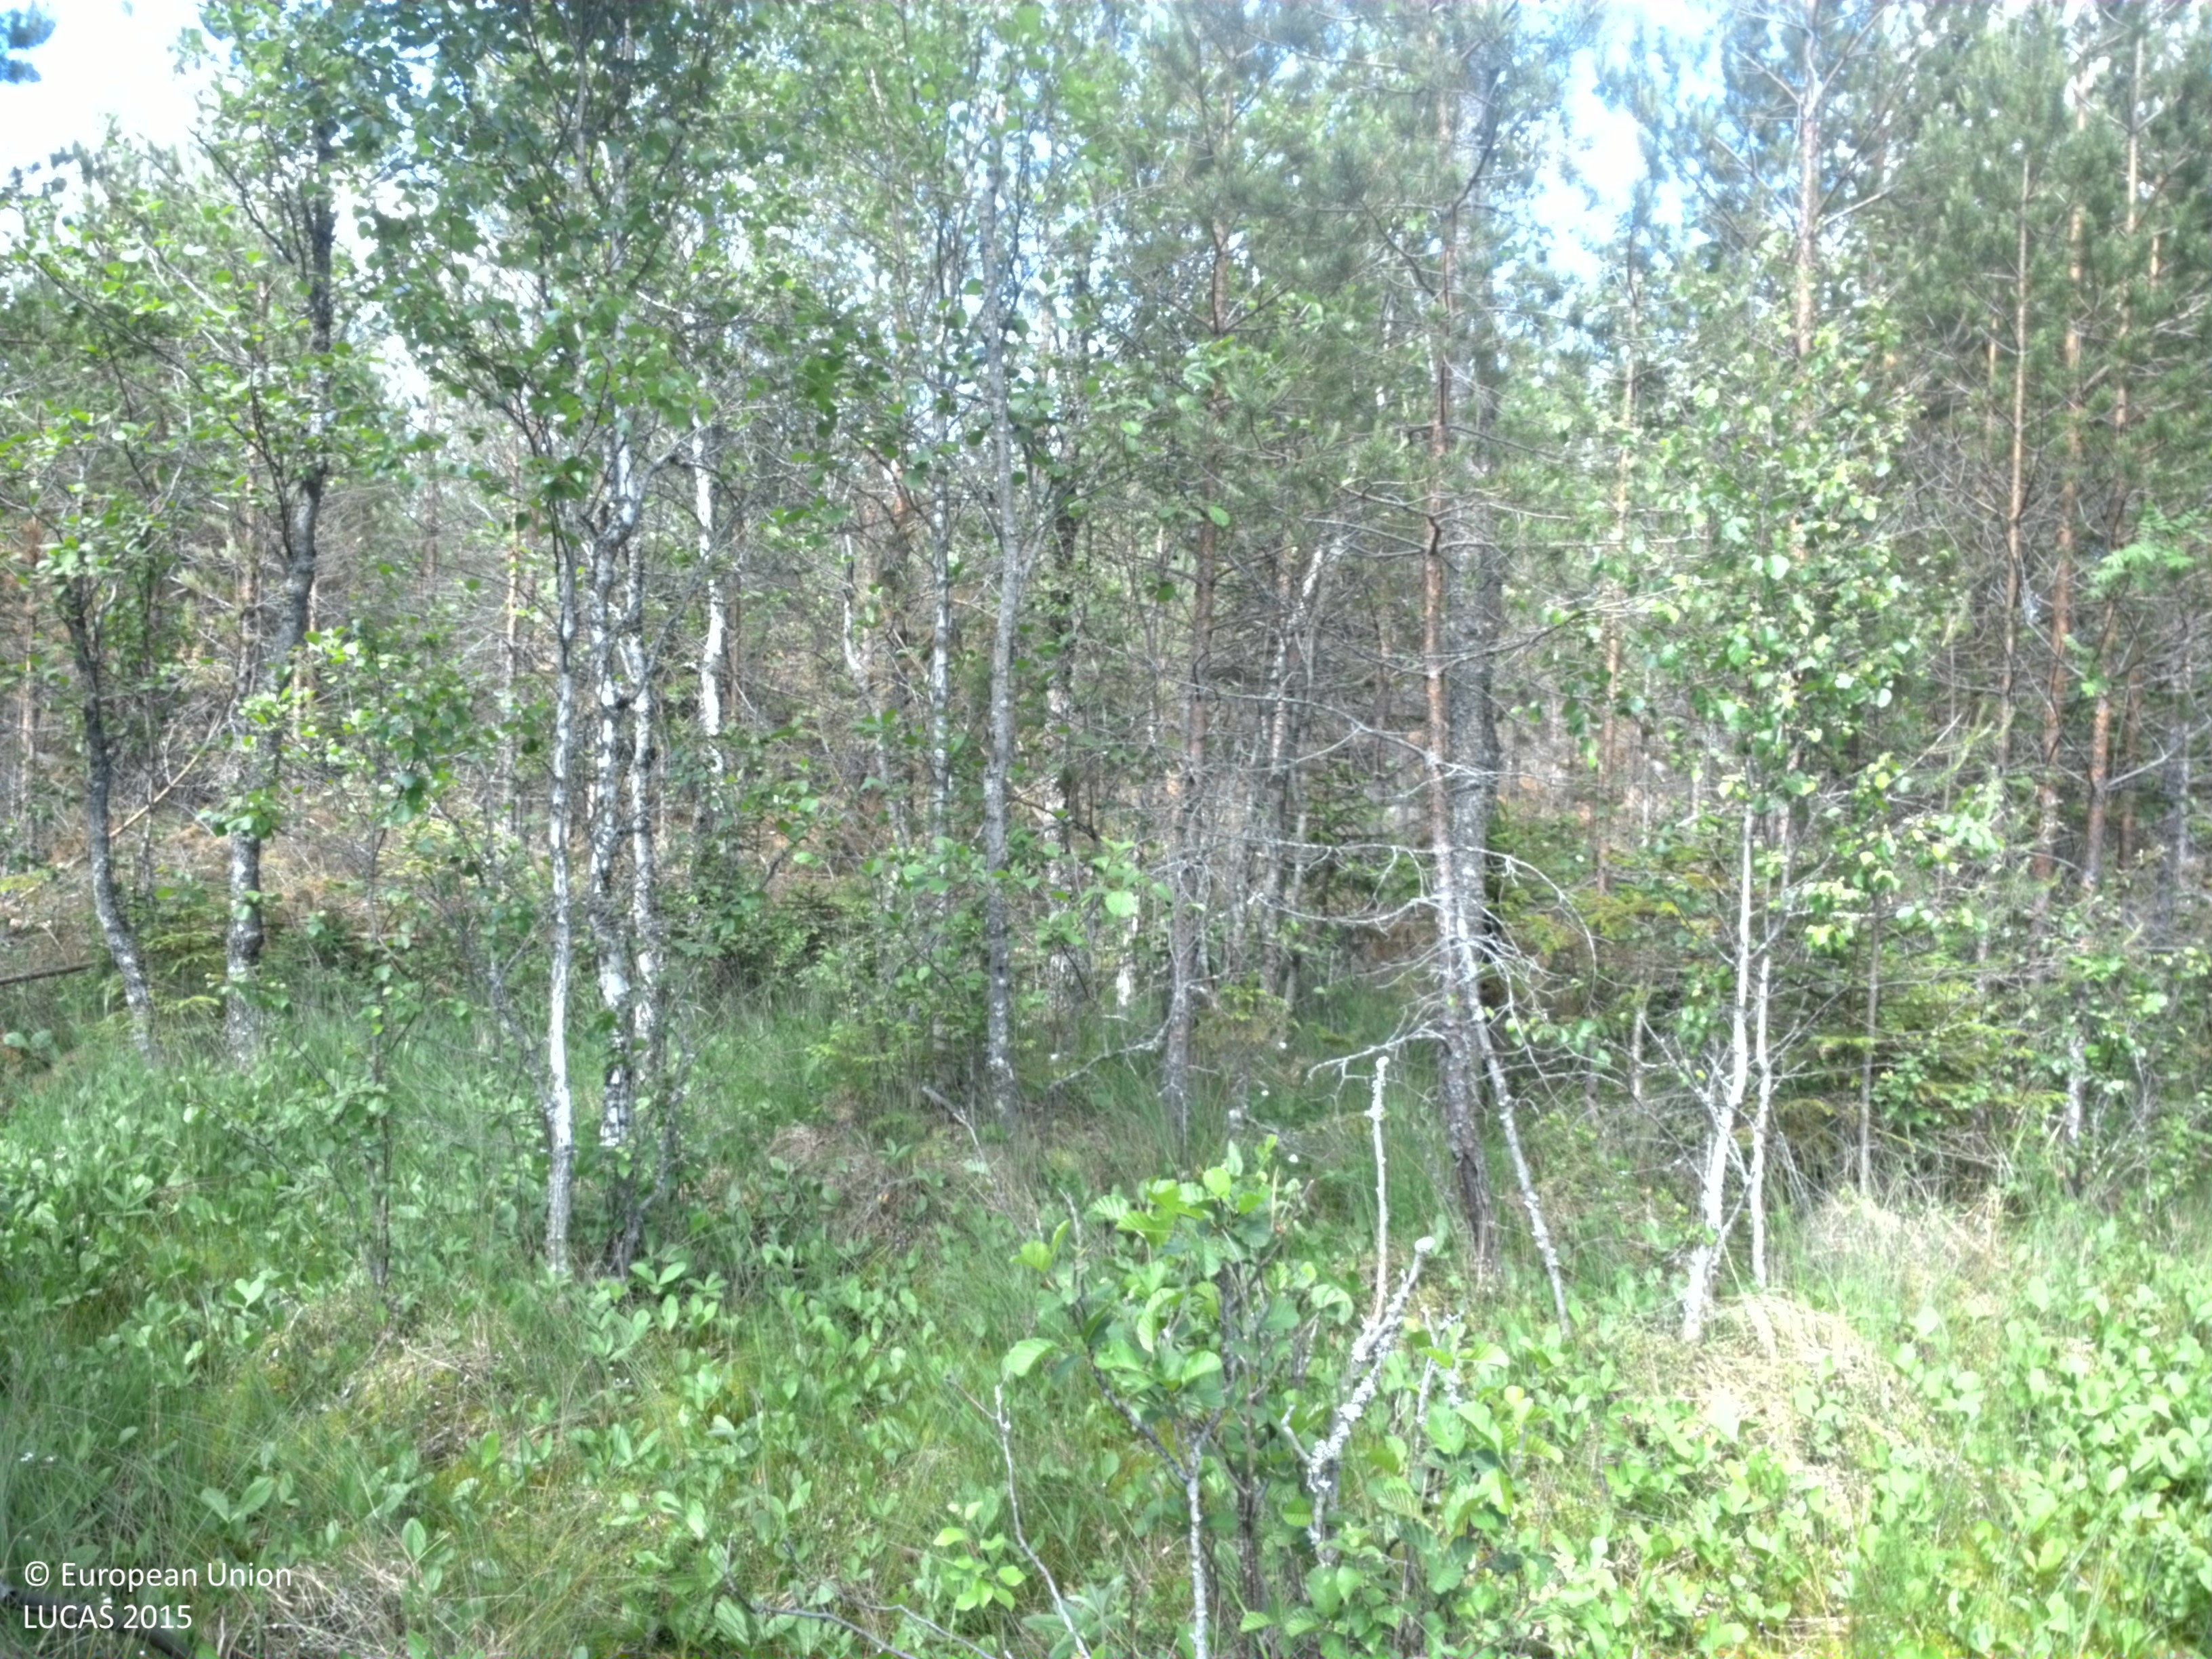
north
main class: Woodland
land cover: Pine dominated mixed woodland
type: boreal forest
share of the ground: 25 - 50 %
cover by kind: lichens and mosses 50 %, coniferous forest trees 30 %, broadleaved forest trees 10 %, herbaceous plants 10 %
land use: Forestry
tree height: > 5 m
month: July
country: SE
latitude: 60.0066
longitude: 17.0038
